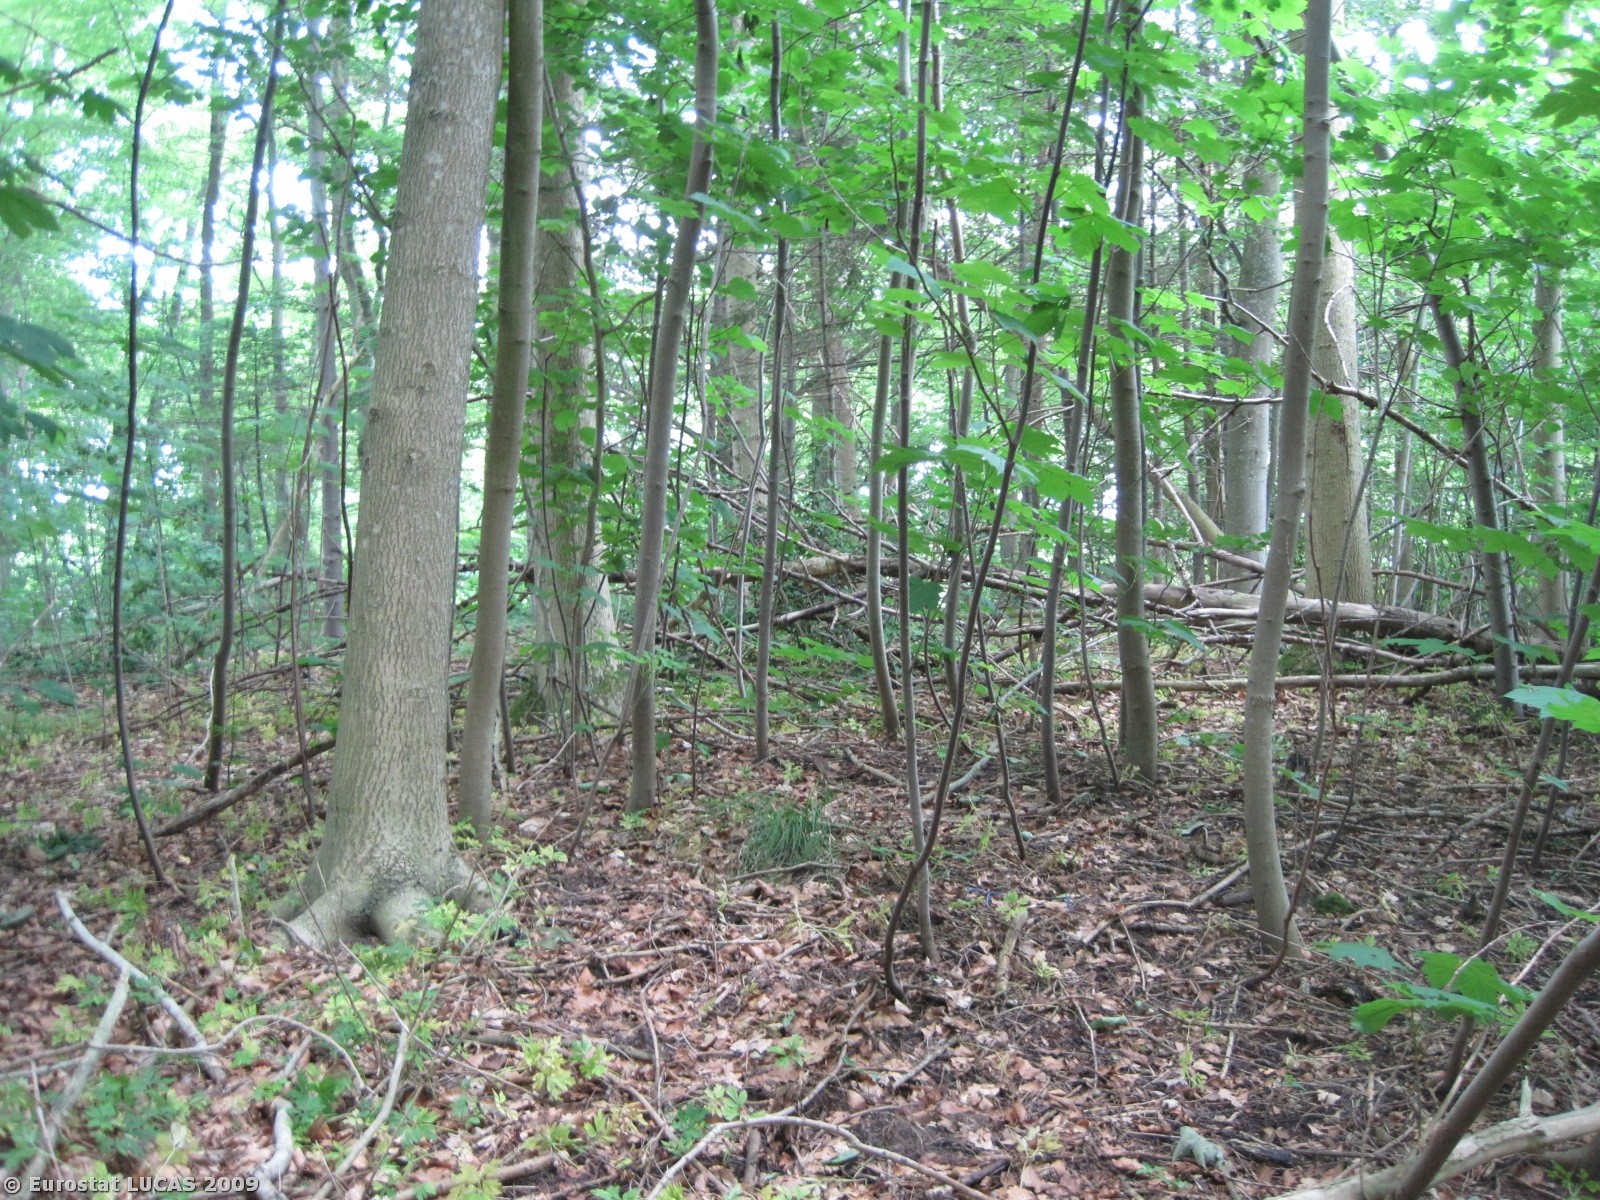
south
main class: Woodland
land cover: Mixed woodland
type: plantations and self-sown exotic forest
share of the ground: > 75 %
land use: Amenities, museums, leisure
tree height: > 5 m
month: June
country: DK
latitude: 57.1582
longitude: 10.2806
